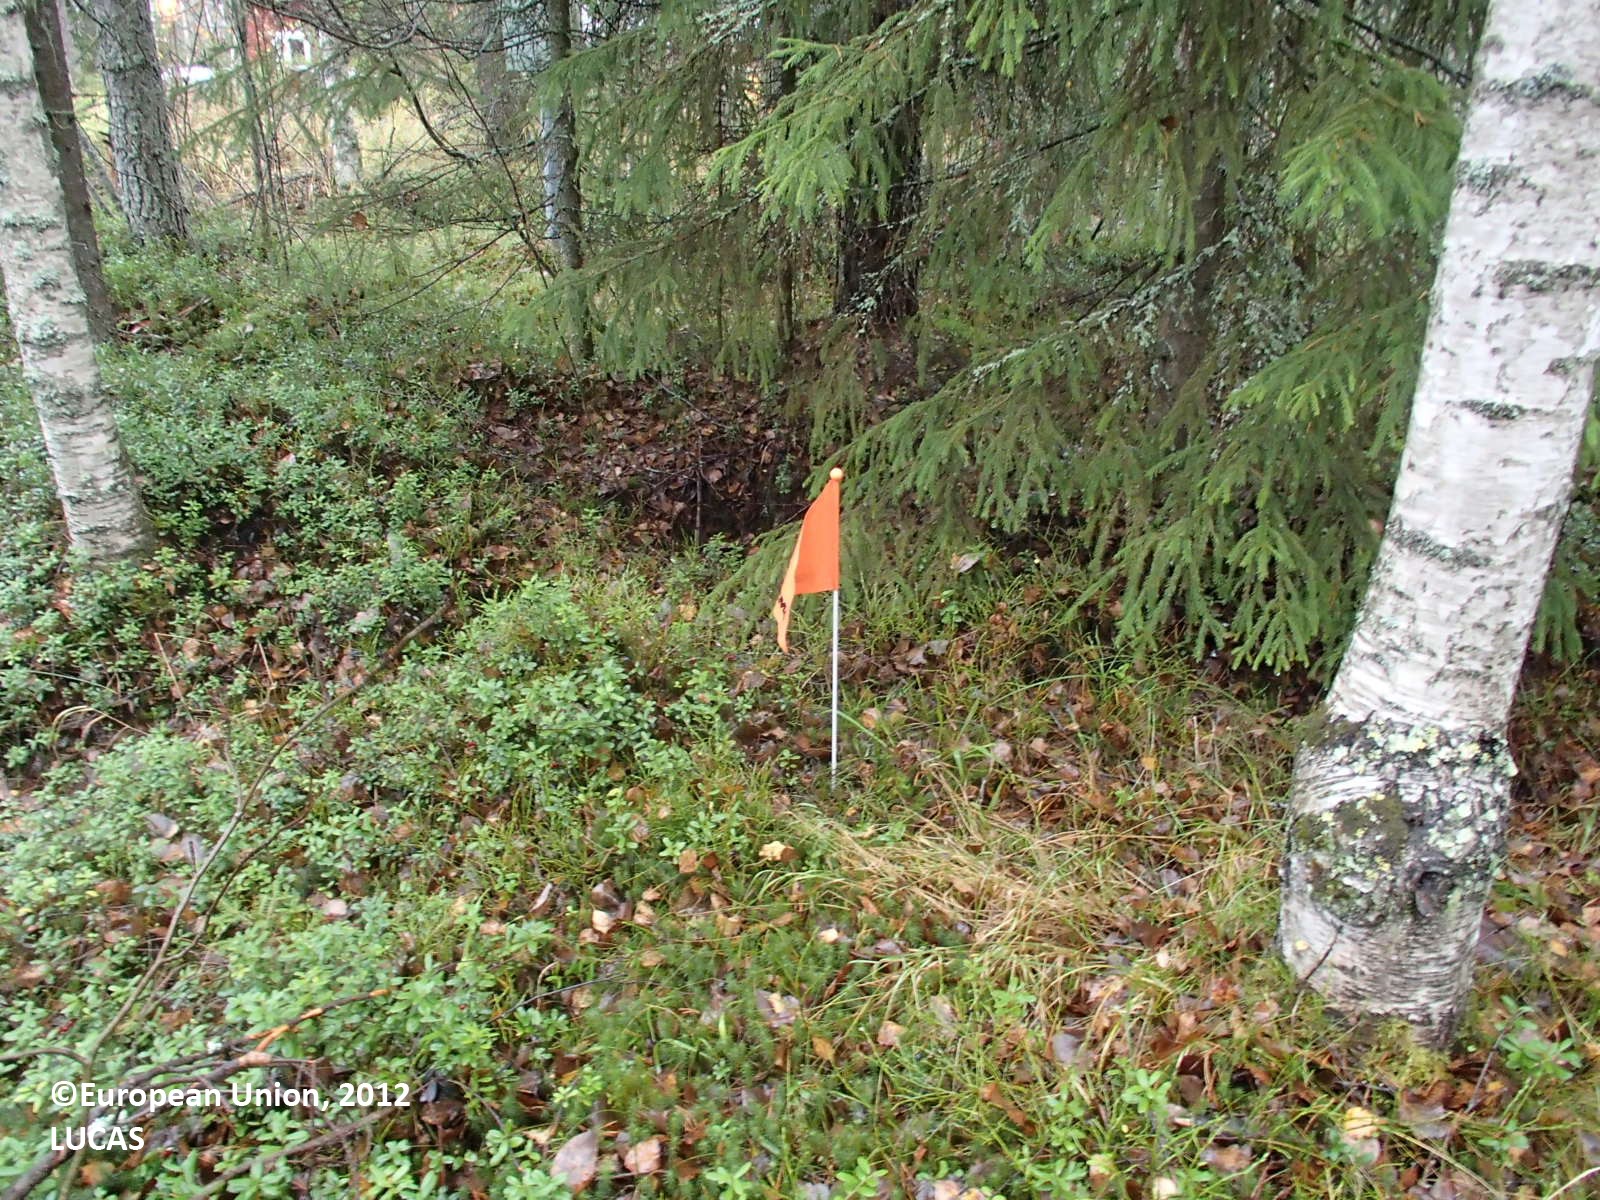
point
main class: Woodland
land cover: Pine dominated mixed woodland
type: boreal forest
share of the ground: > 75 %
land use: Forestry
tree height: > 5 m
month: October
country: FI
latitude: 63.8597
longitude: 26.8340
